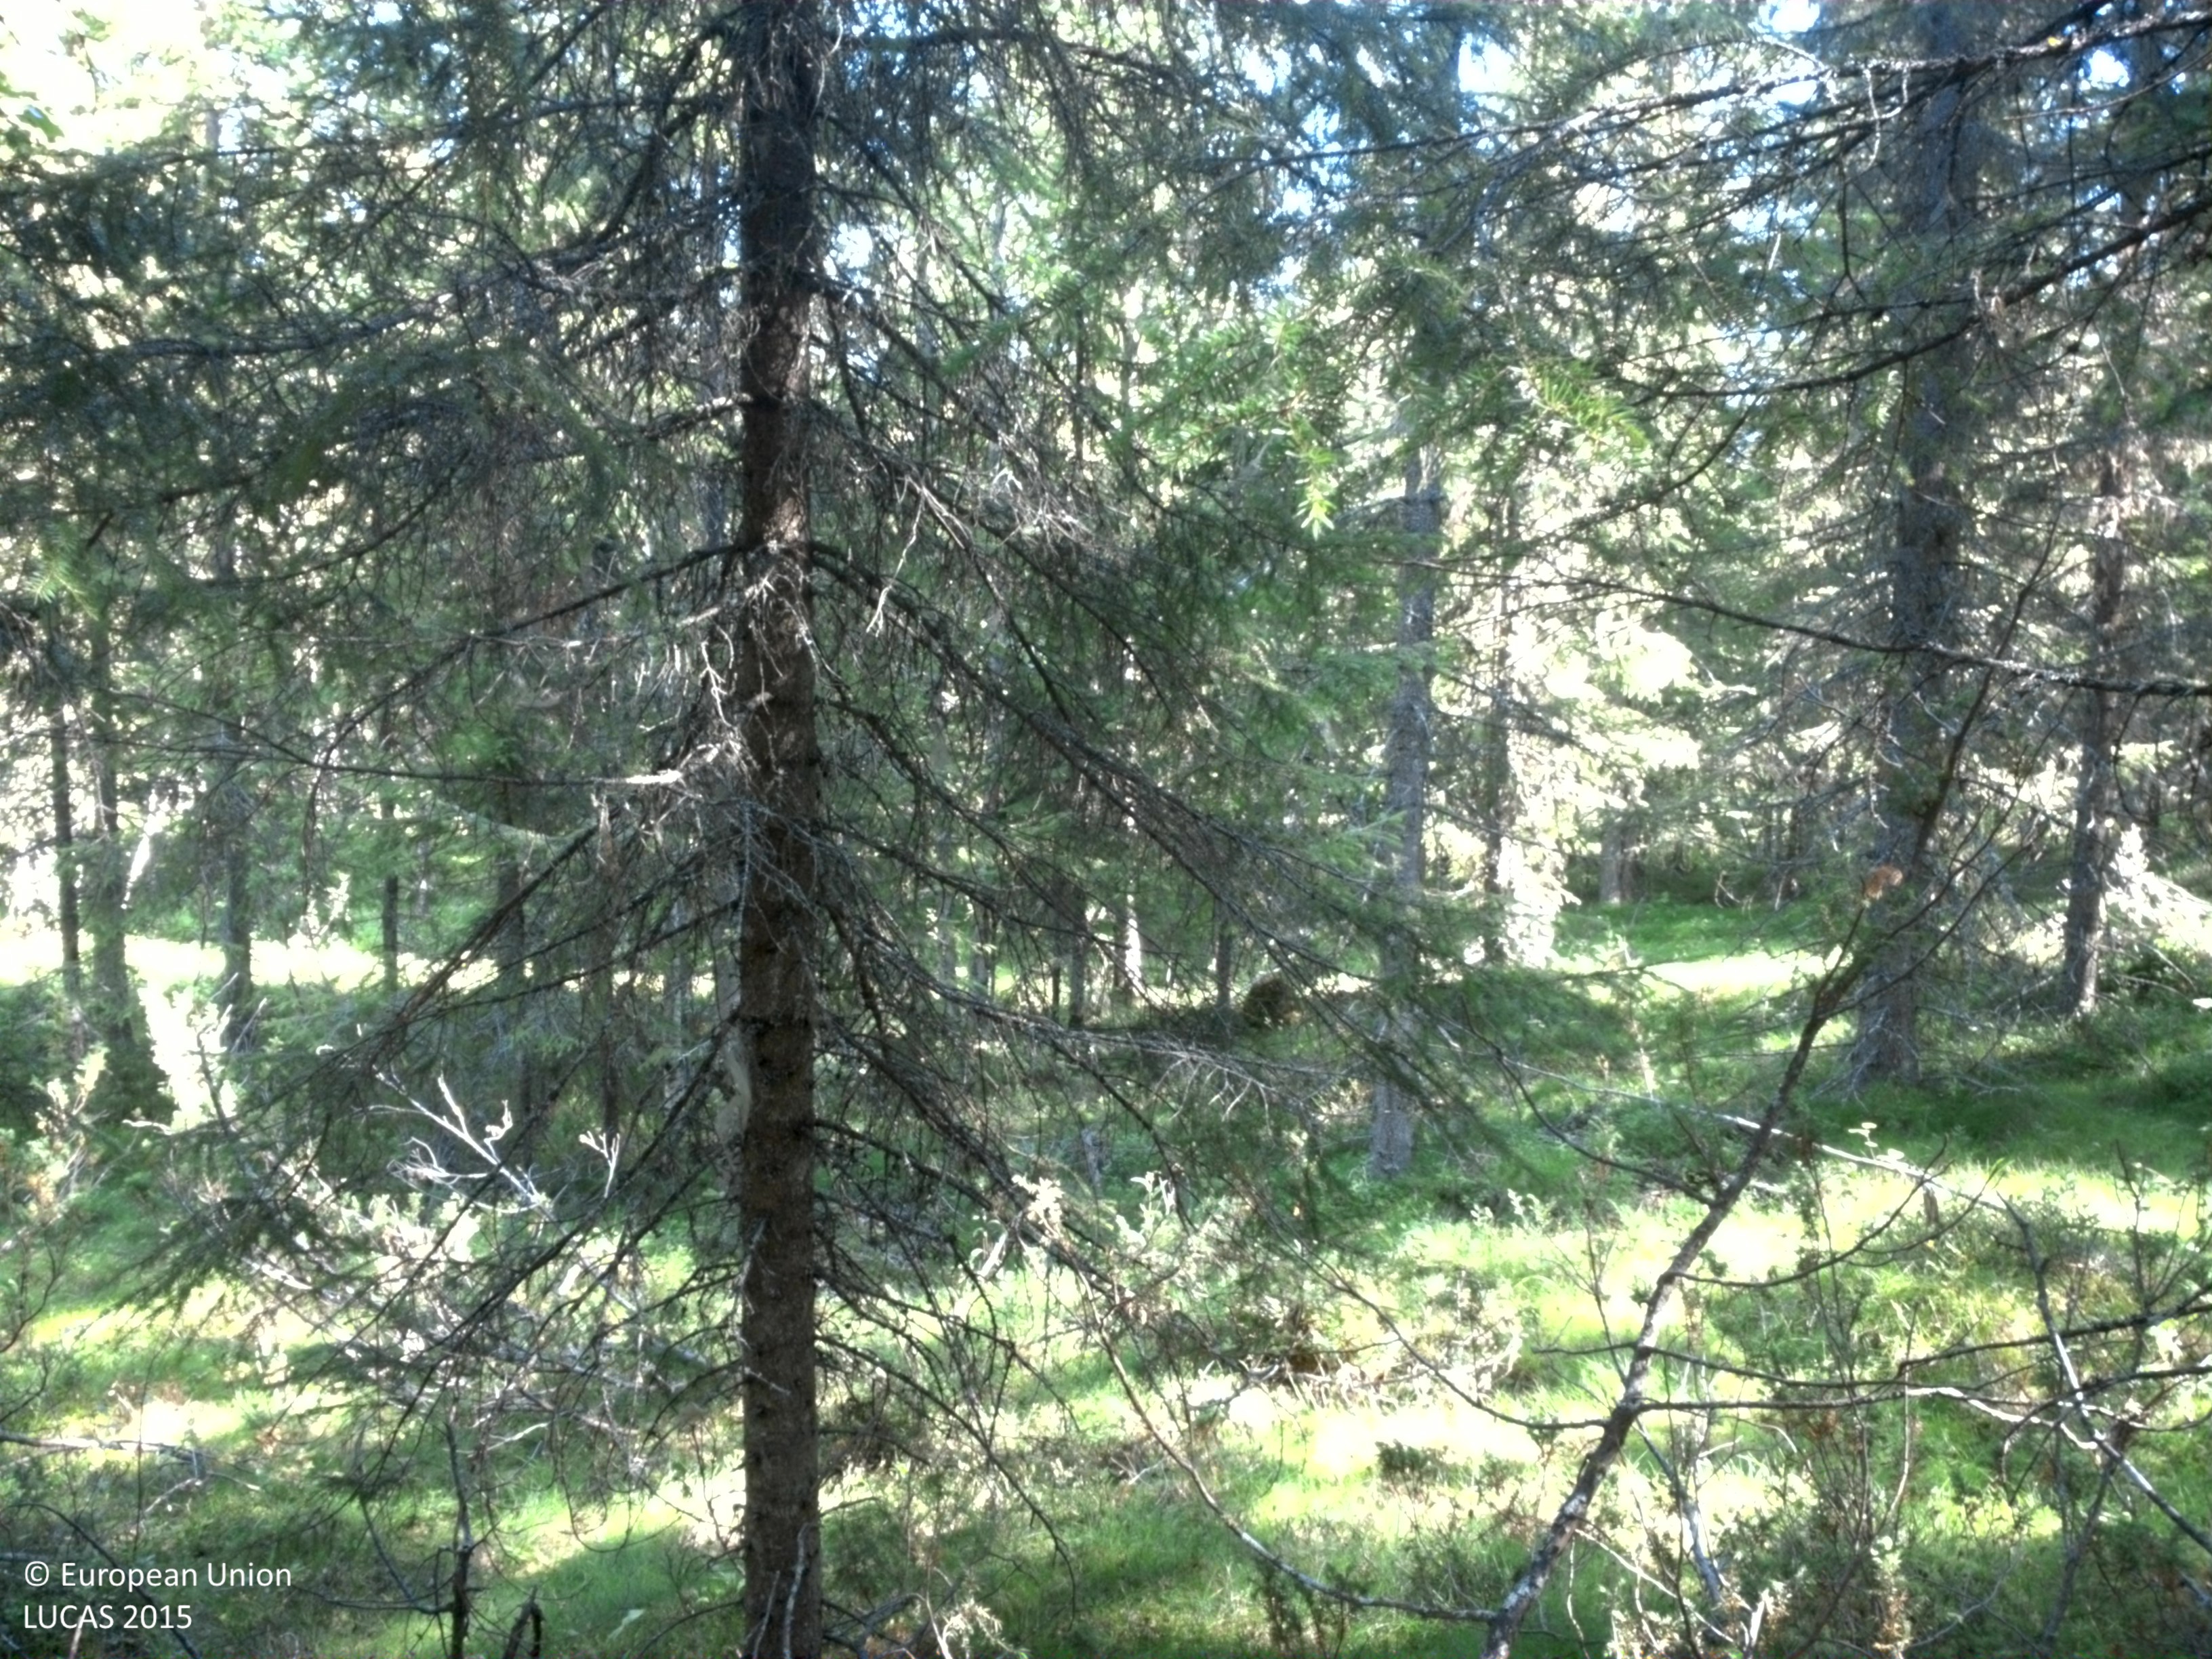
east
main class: Woodland
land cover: Spruce dominated coniferous woodland
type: boreal forest
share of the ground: 50 - 75 %
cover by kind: coniferous forest trees 60 %, herbaceous plants 20 %, shrubs 15 %, broadleaved forest trees 5 %
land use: Forestry
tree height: > 5 m
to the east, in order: Spruce dominated coniferous woodland; Ditches and canals; Paved roads, cycling and walking lanes; Ditches and canals; Pine dominated coniferous woodland; Spruce dominated coniferous woodland
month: August
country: SE
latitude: 64.4872
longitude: 18.6878
